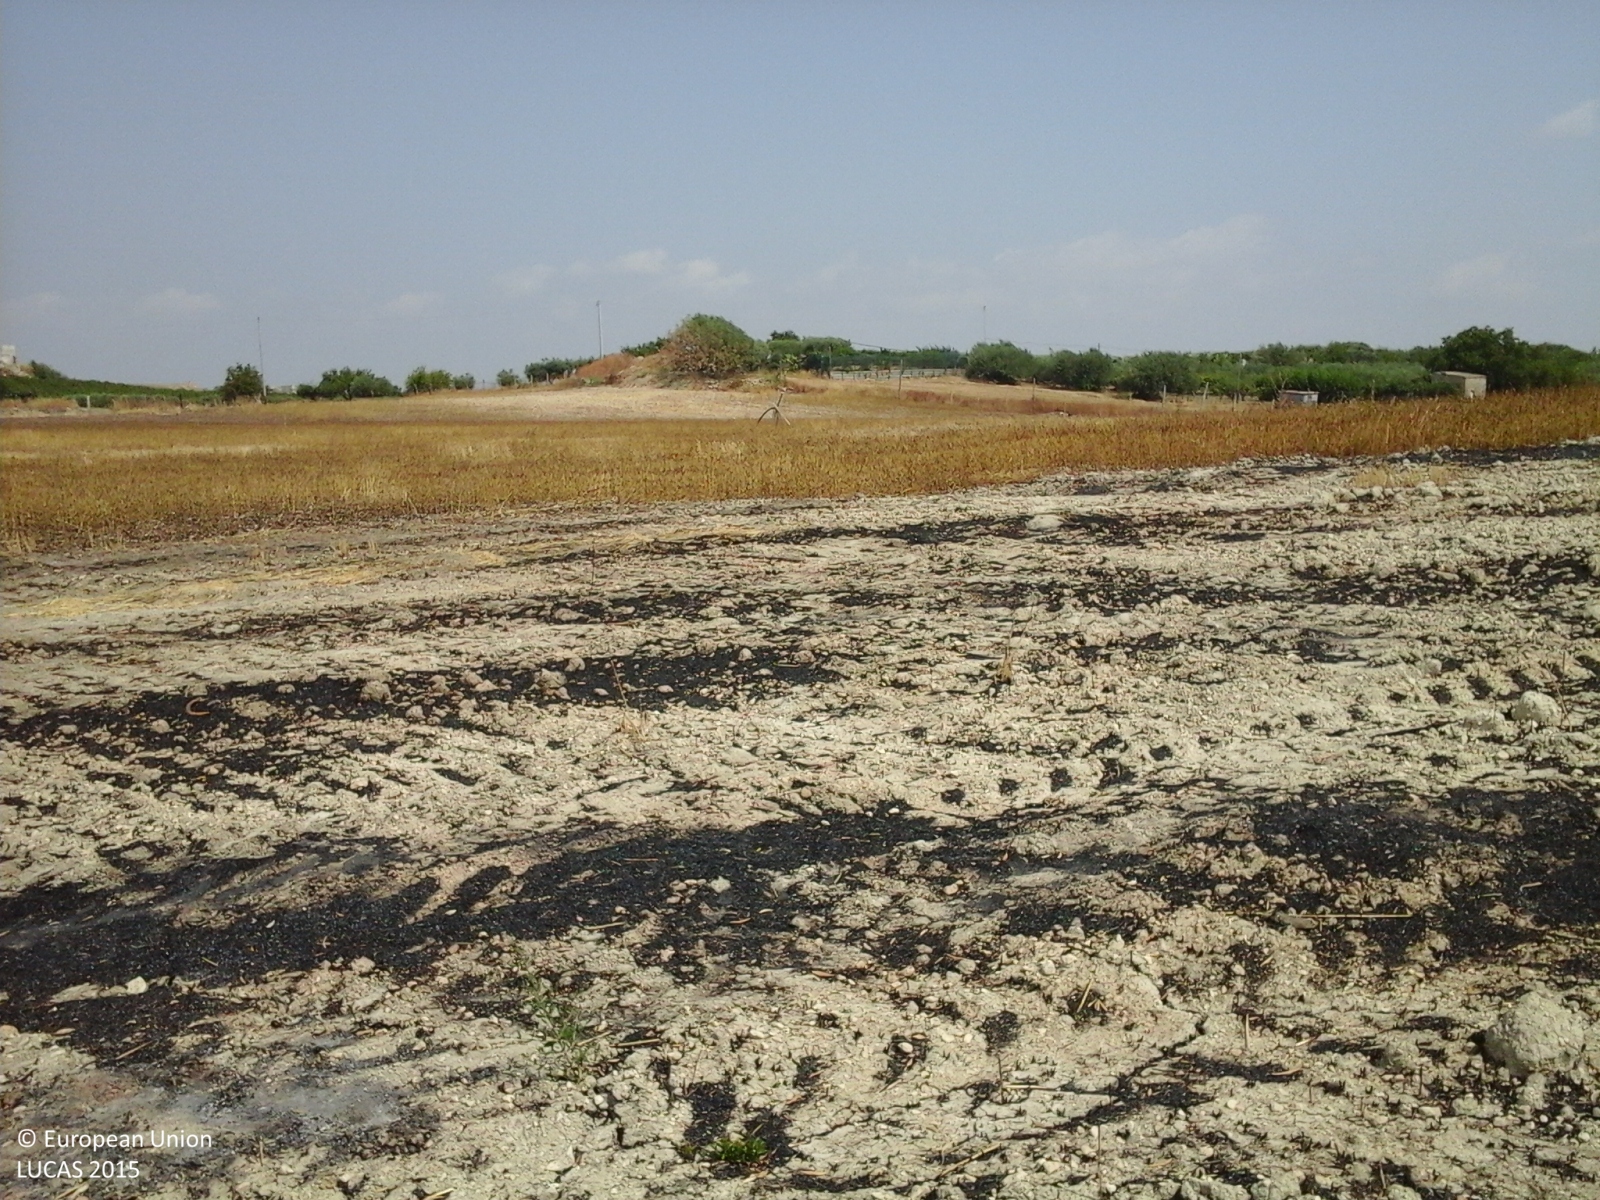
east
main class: Cropland
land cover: Durum wheat
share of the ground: > 75 %
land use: Agriculture (excluding fallow land and kitchen gardens)
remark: Burnt area
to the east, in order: Durum wheat; Electric lines; Durum wheat; Grass margins; Paved roads, cycling and walking lanes; Fences; Other fruit trees and berries; Fences; Tracks; Durum wheat
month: July
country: IT
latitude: 37.2475
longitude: 13.9489
